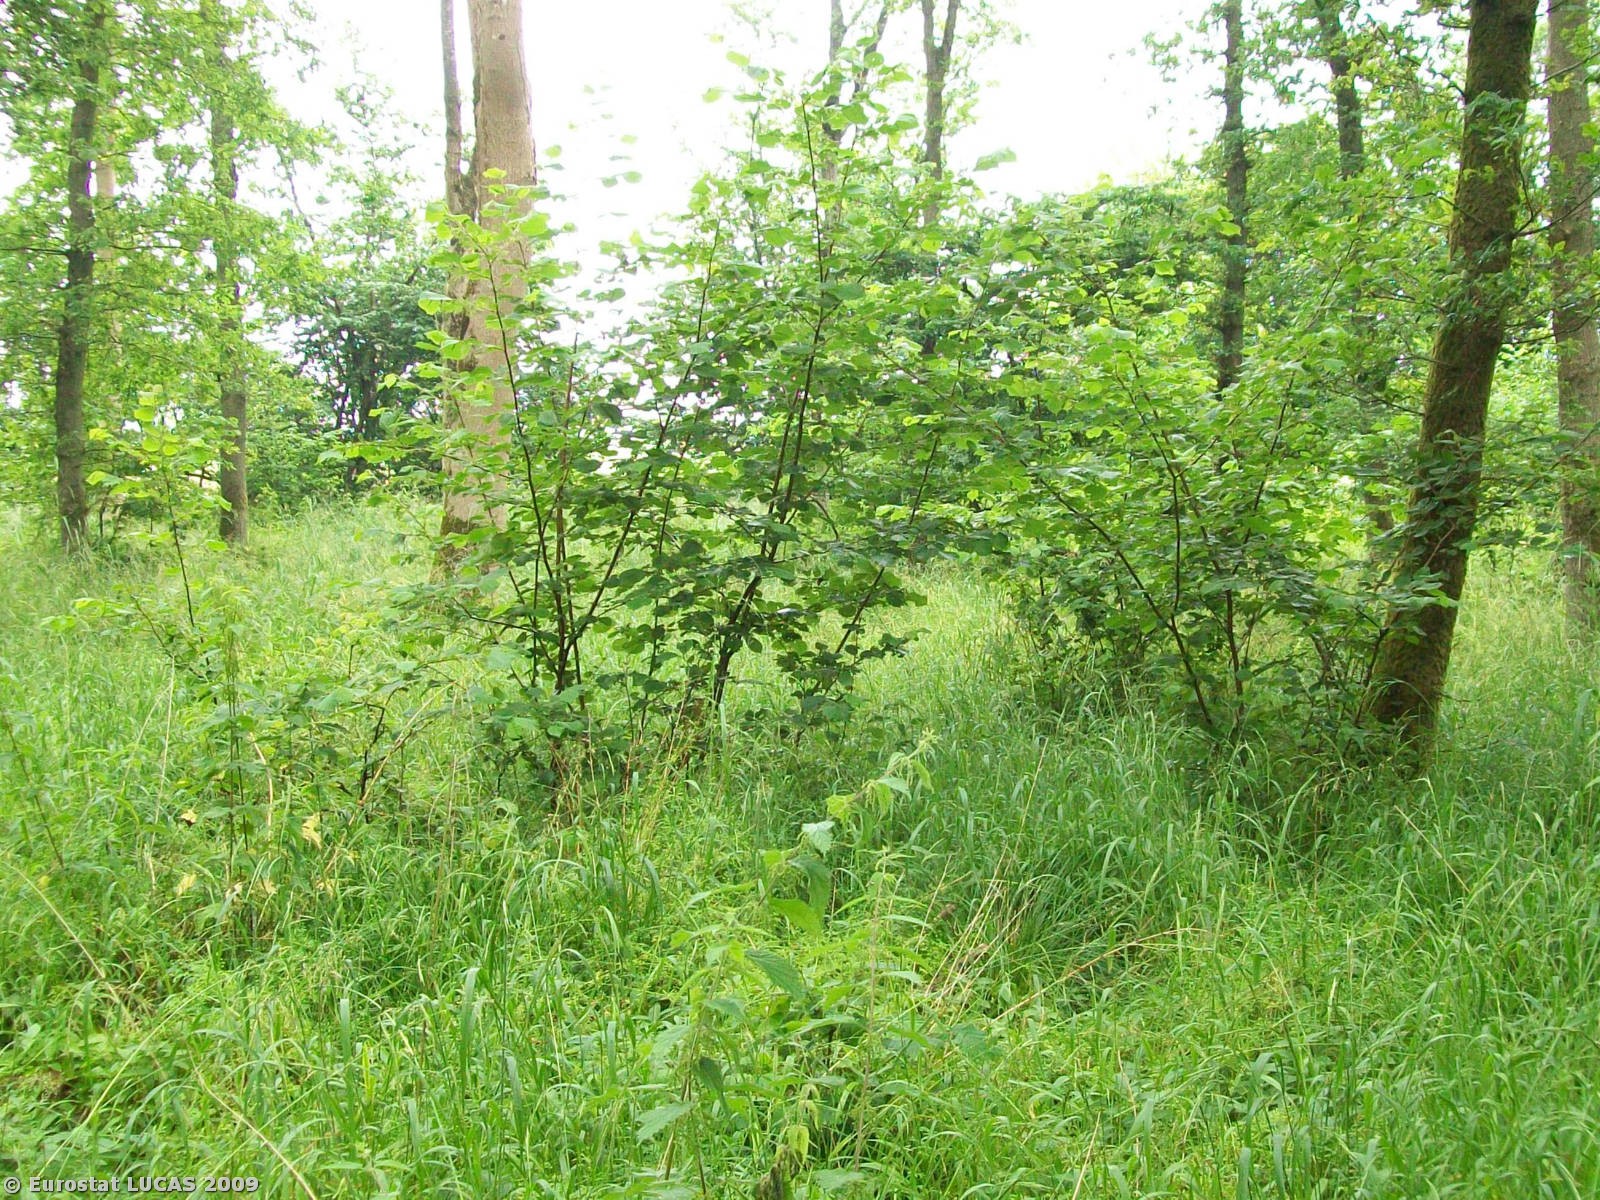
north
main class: Woodland
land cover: Broadleaved woodland
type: mesophytic deciduous forest
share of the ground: > 75 %
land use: Sport
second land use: Community services
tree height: > 5 m
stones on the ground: < 10 %
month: June
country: GB
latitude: 51.2161
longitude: -2.2165
